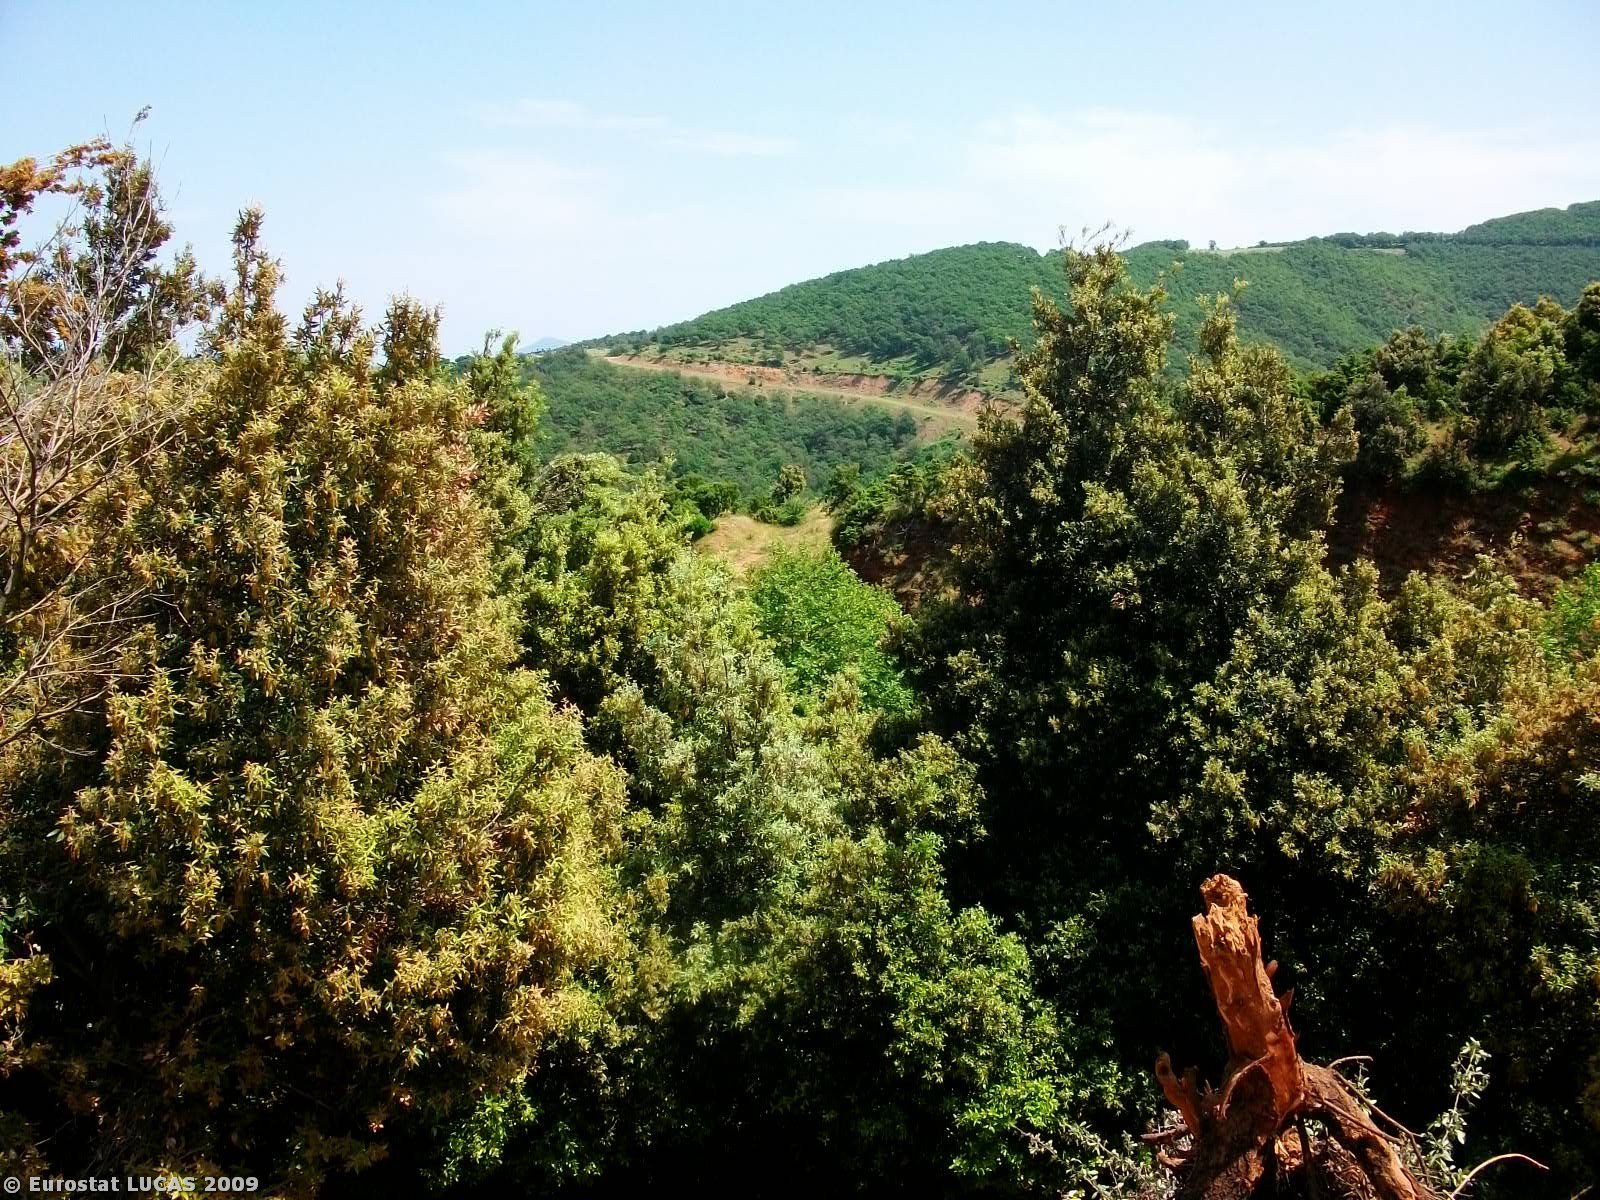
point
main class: Woodland
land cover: Mixed woodland
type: mesophytic deciduous forest
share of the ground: > 75 %
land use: Forestry
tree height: > 5 m
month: May
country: GR
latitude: 39.0858
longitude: 22.7372
